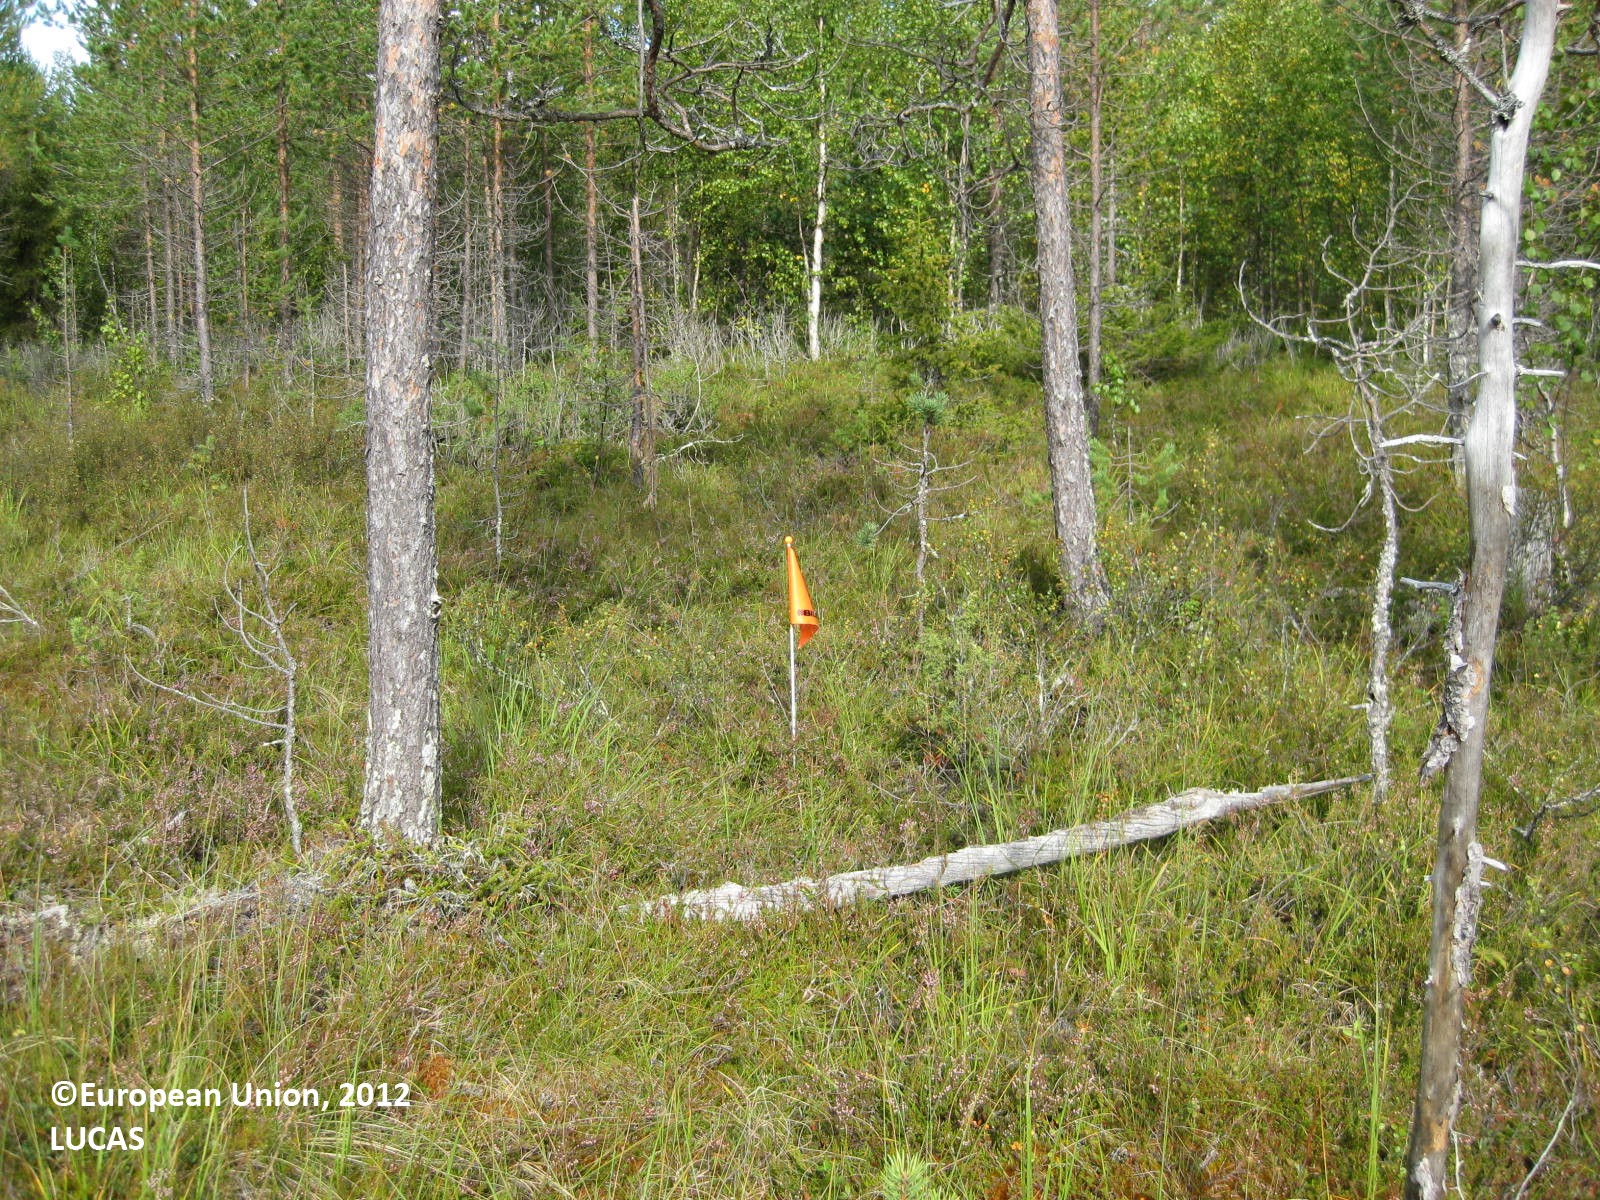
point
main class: Woodland
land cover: Pine dominated coniferous woodland
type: boreal forest
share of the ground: 25 - 50 %
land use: Forestry
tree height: > 5 m
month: August
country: FI
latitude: 66.2192
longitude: 29.7308
